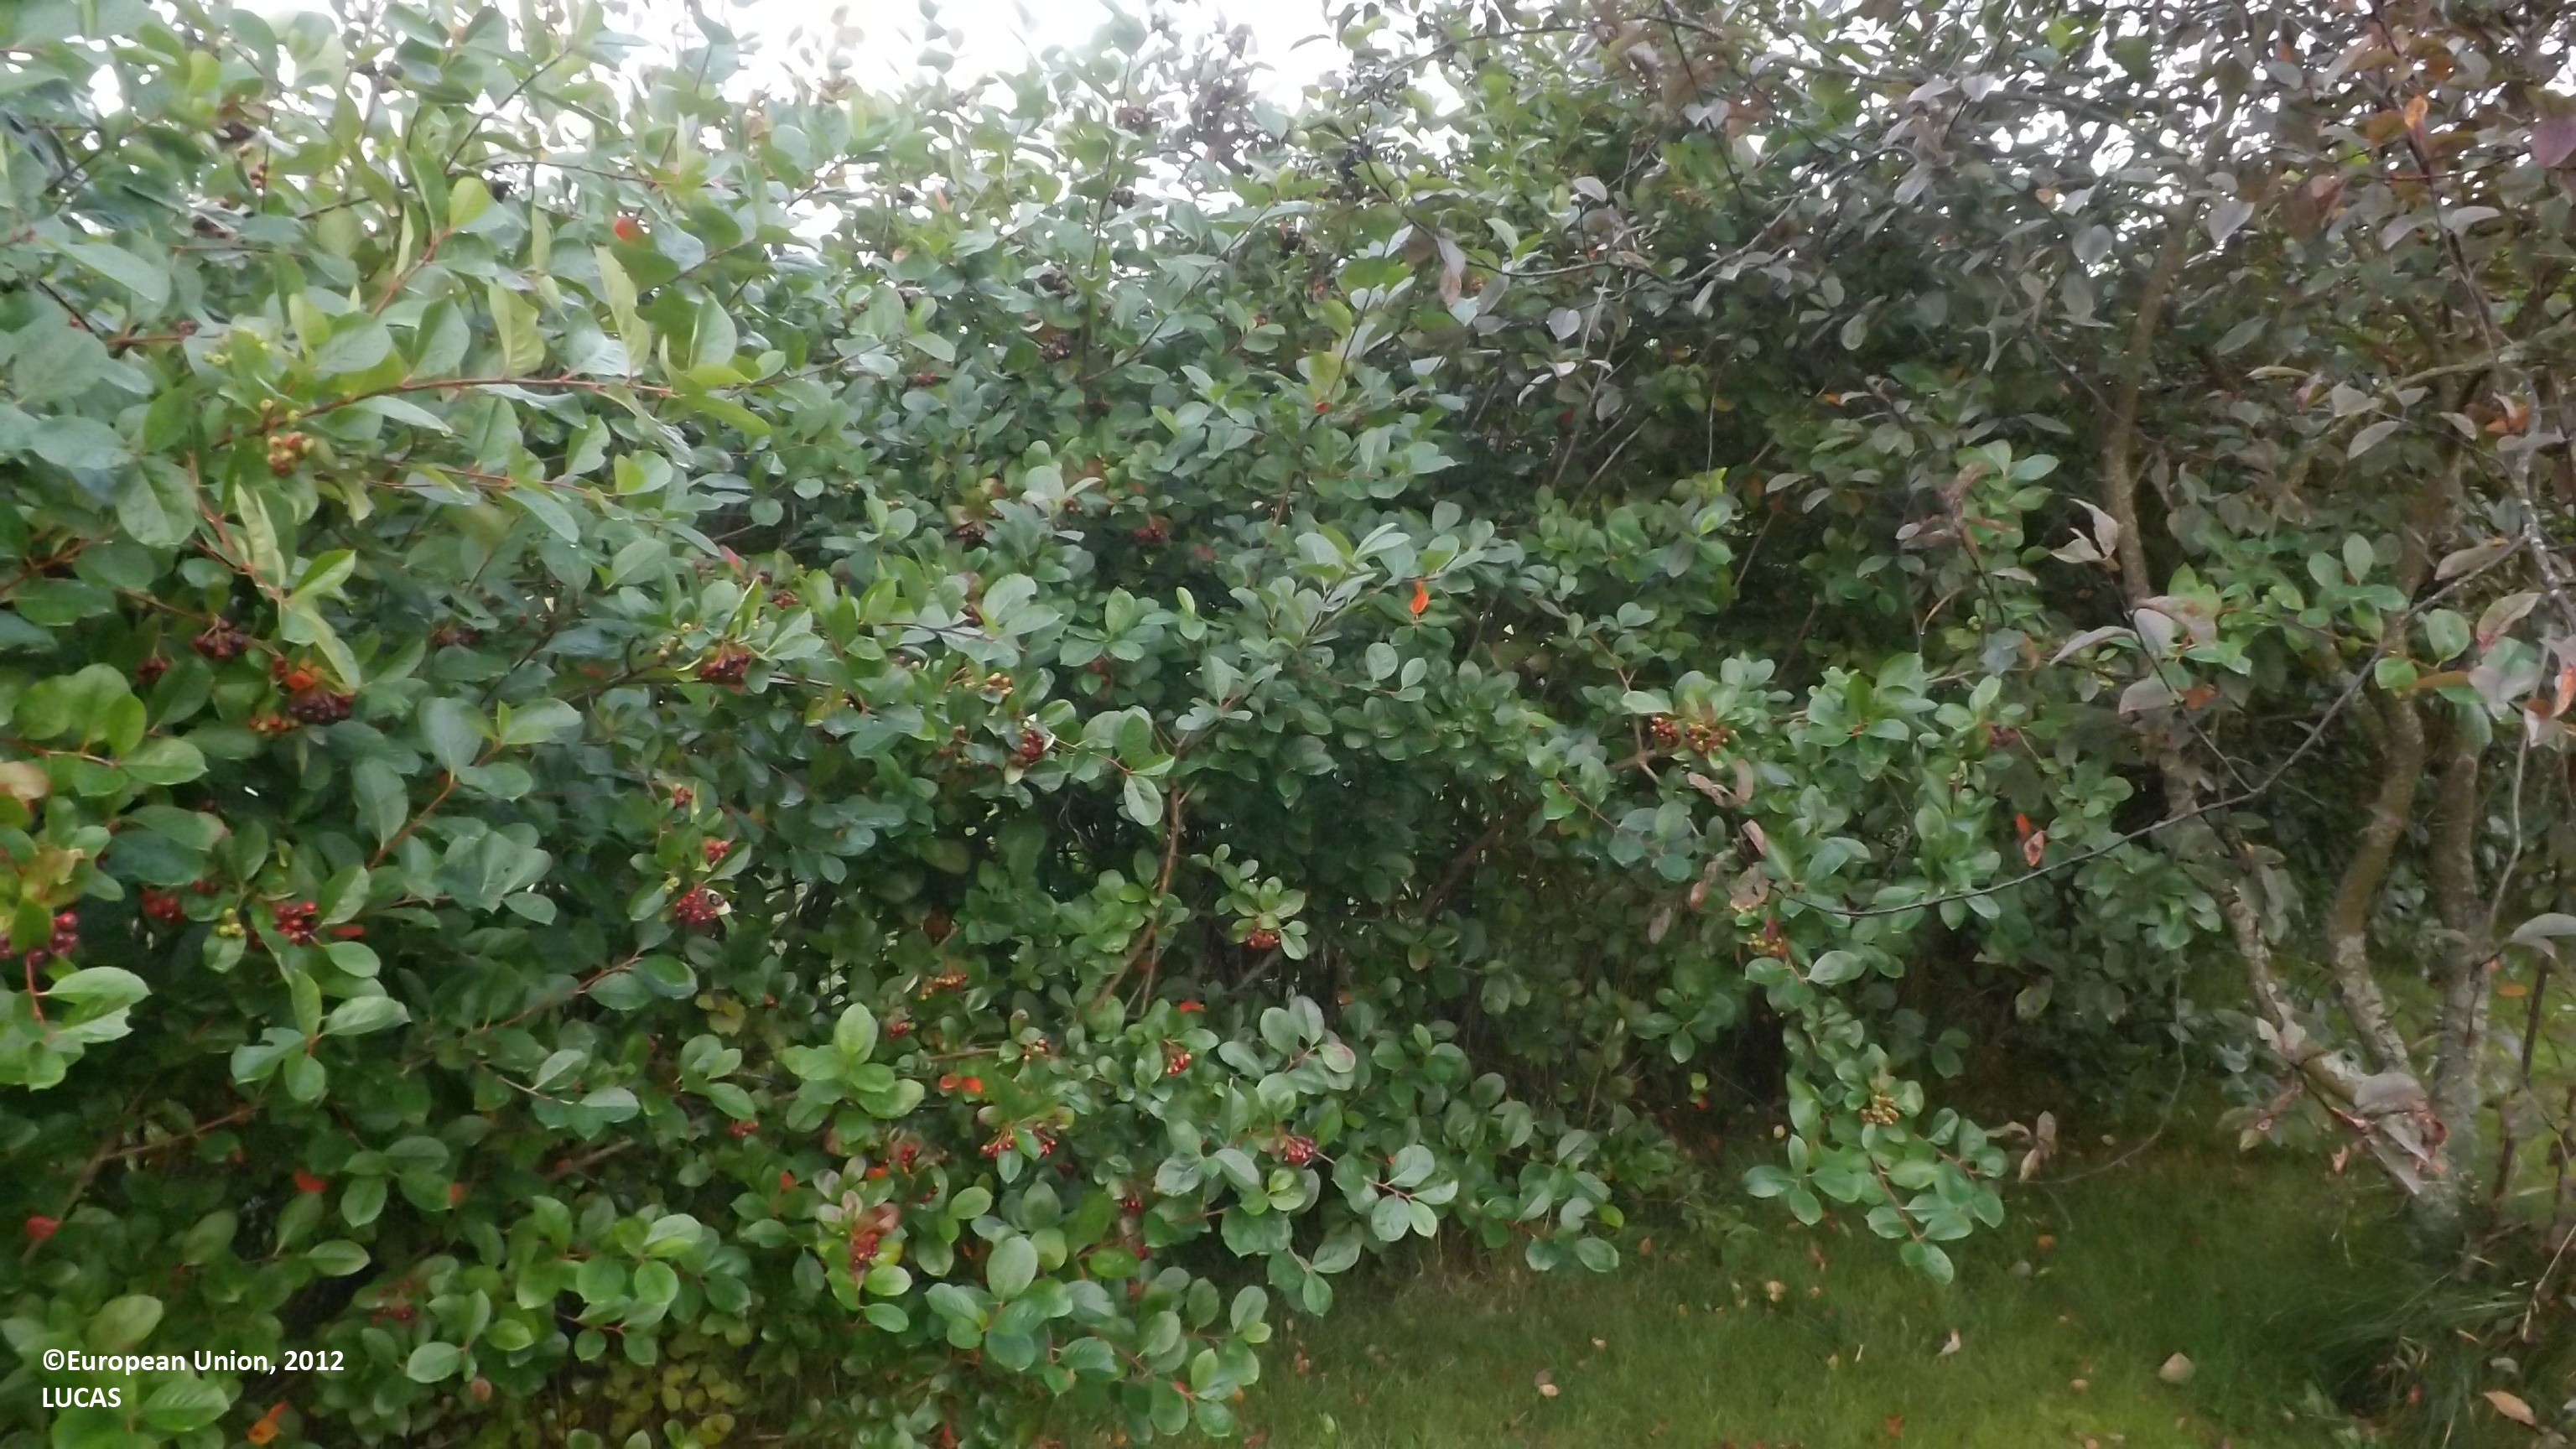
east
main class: Grassland
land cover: Grassland with sparse tree/shrub cover
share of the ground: 10 - 25 %
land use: Residential
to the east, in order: Grassland with sparse tree/shrub cover; Managed hedges; Ditches and canals; Grass margins; Paved roads, cycling and walking lanes; Grass margins; Ditches and canals; Abandoned hedges; Grassland without tree/shrub cover; Ditches and canals; Other bare soil; Artificial constructions in urban areas; Other bare soil; Broadleaved woodland; Grassland with sparse tree/shrub cover; Broadleaved woodland; Inland running water; Broadleaved woodland; Grassland with sparse tree/shrub cover; Artificial constructions in urban areas
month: August
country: FI
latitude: 63.9111
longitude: 23.9034
